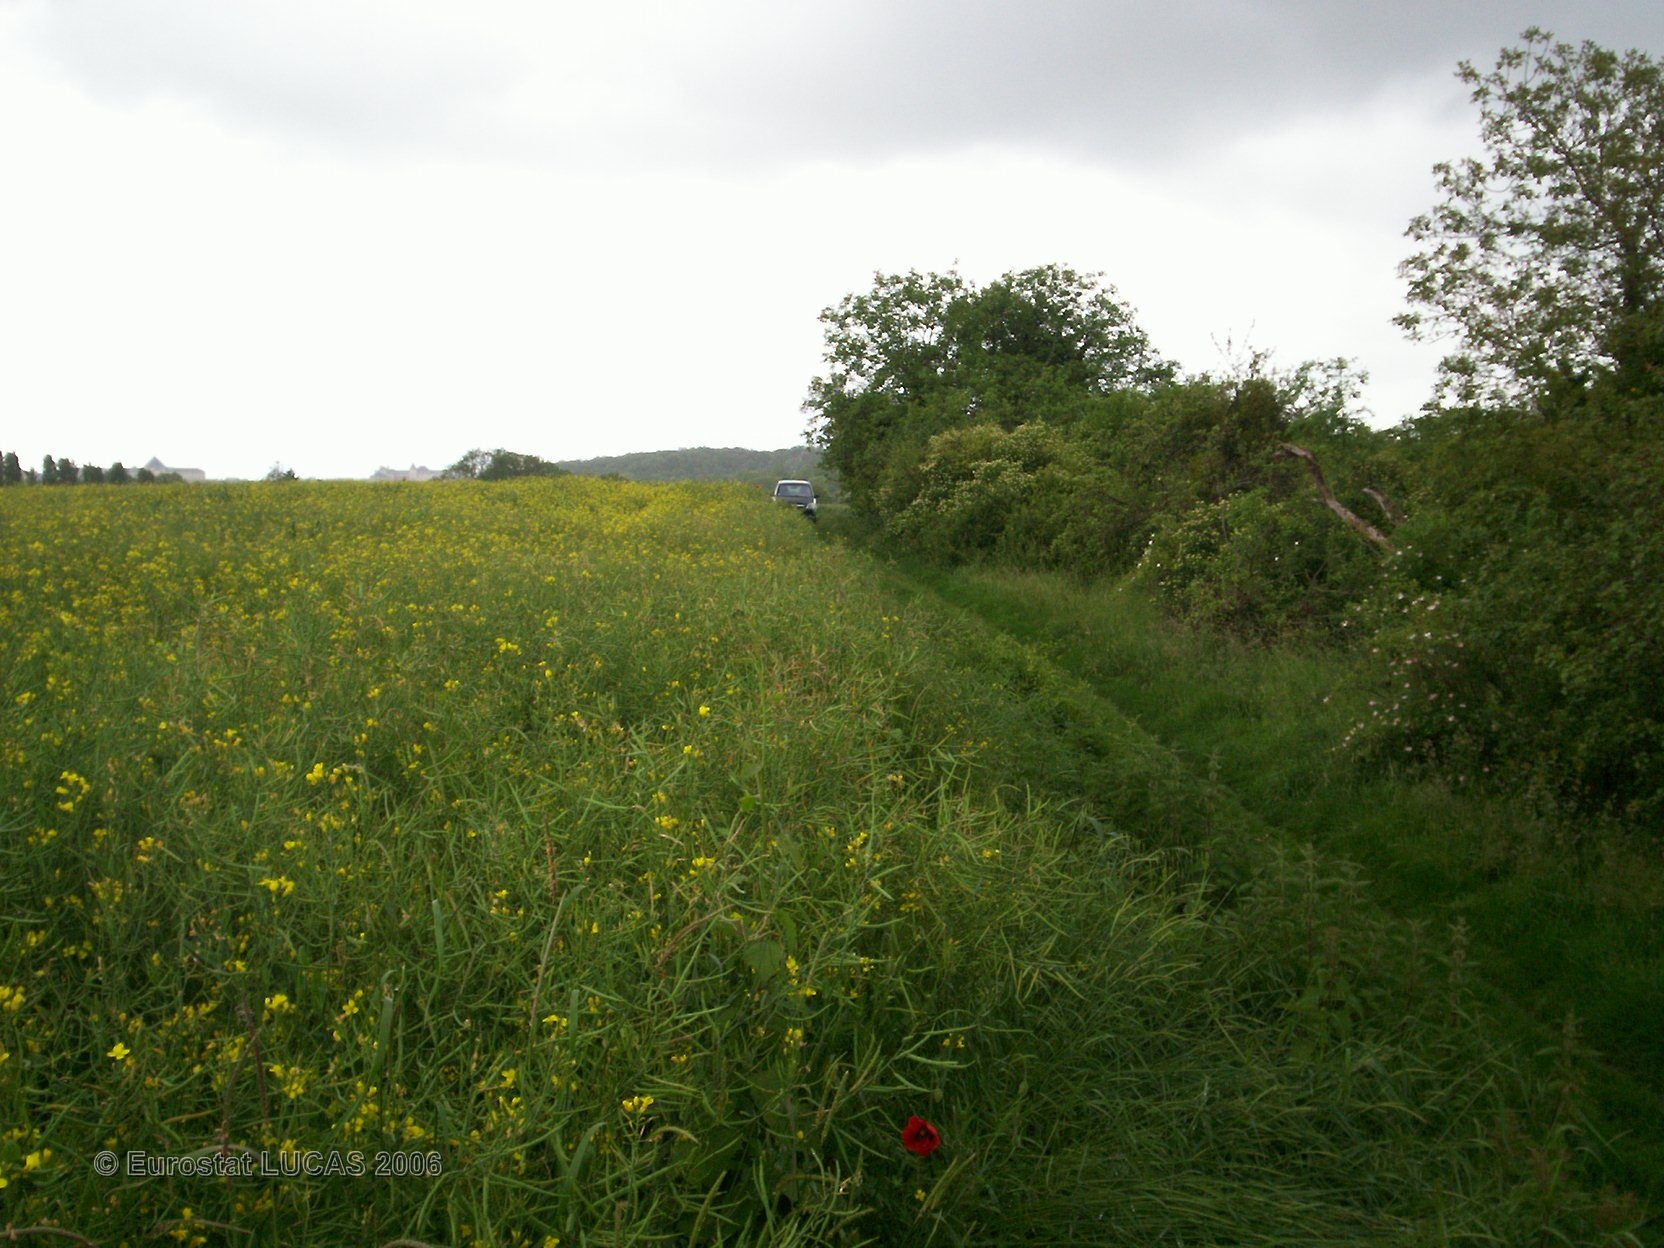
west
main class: Cropland
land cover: Rape and turnip rape
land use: Agriculture (excluding fallow land and kitchen gardens)
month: May
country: FR
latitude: 48.8751
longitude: 2.8322
